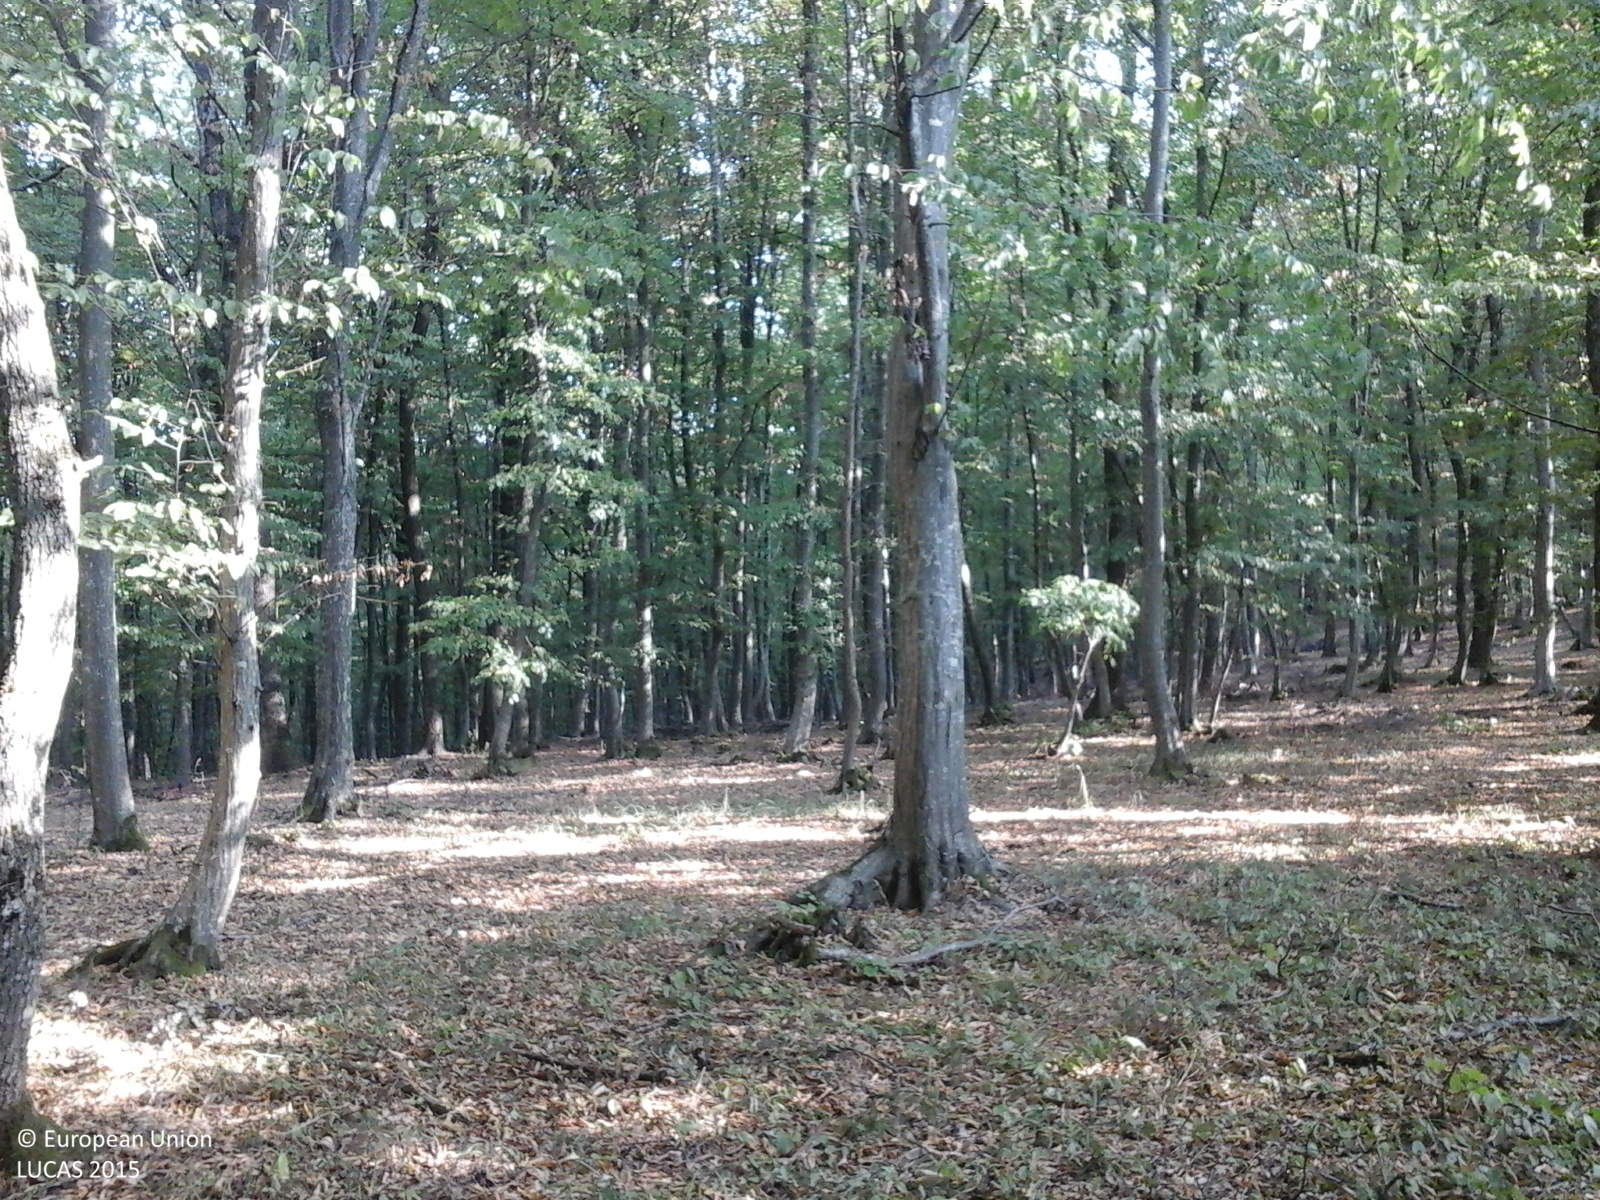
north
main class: Woodland
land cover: Broadleaved woodland
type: beech forest
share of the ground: > 75 %
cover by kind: broadleaved forest trees 100 %
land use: Forestry
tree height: > 5 m
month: September
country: RO
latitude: 46.8803
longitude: 24.4570
